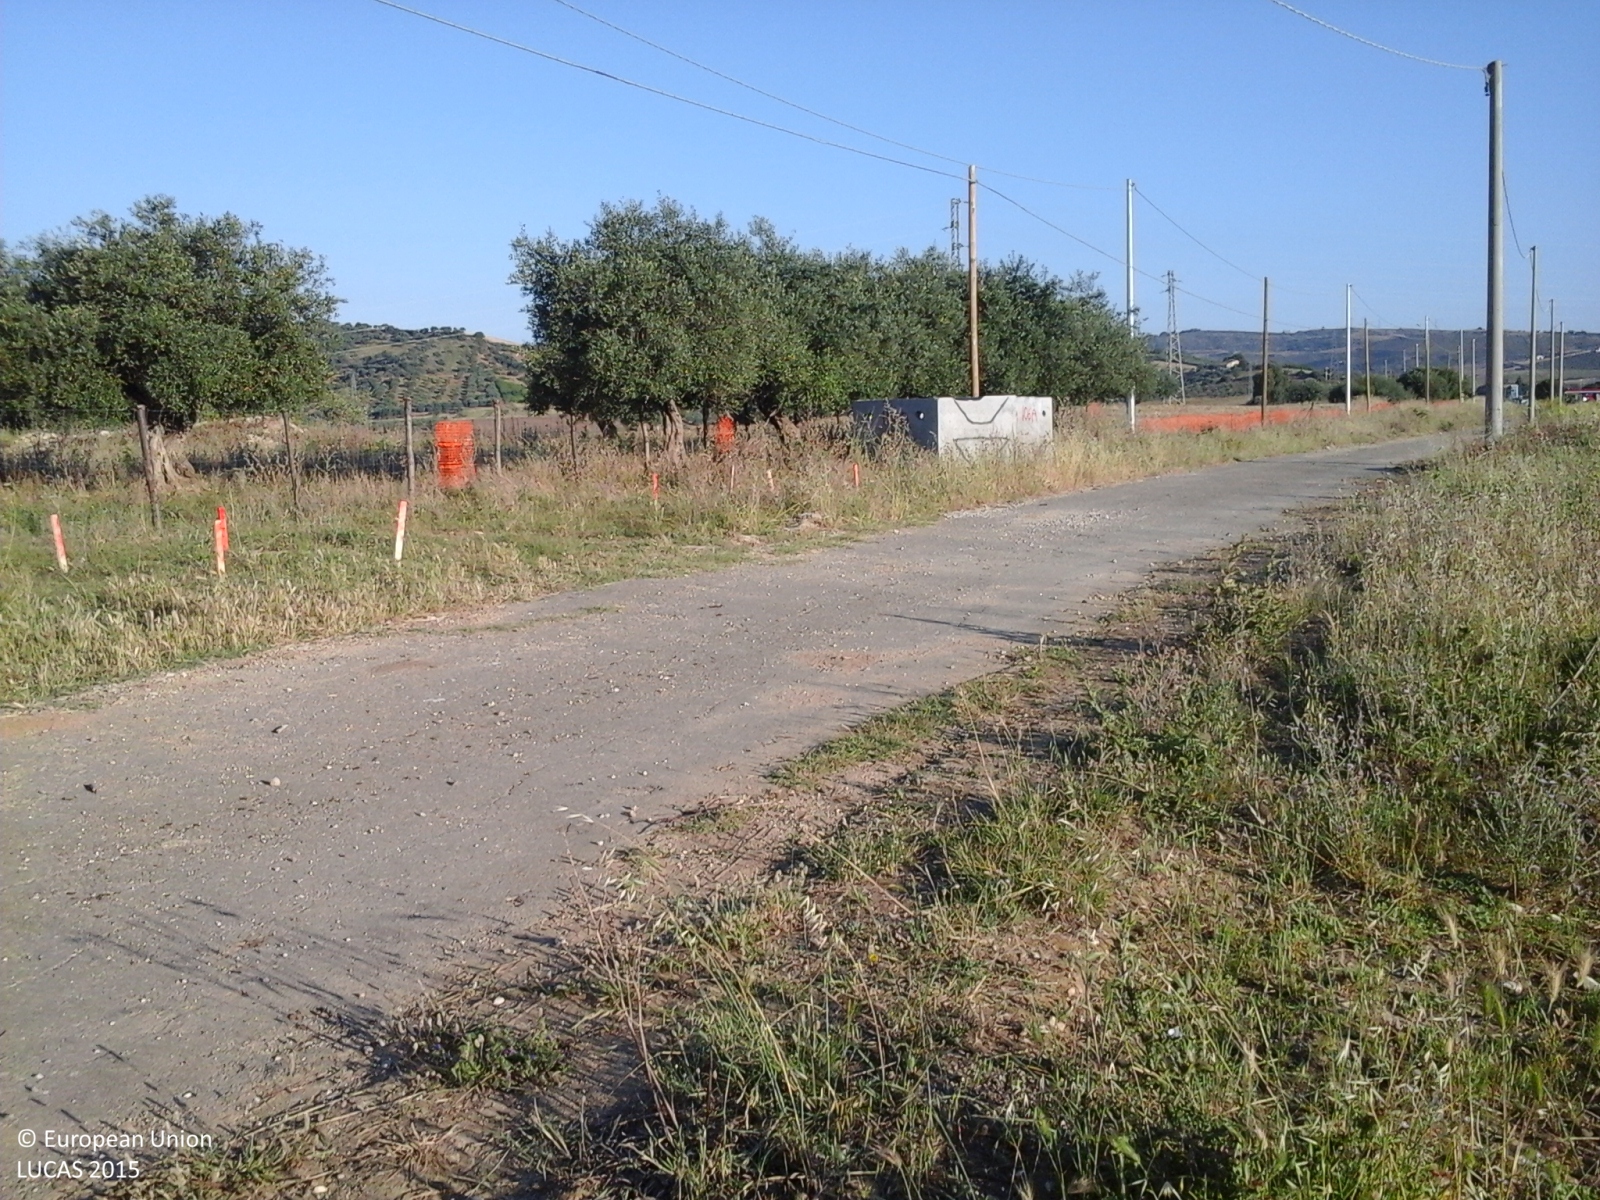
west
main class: Grassland
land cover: Spontaneously vegetated surfaces
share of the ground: > 75 %
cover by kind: herbaceous plants 100 %
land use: Fallow land
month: June
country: IT
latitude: 37.8644
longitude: 13.5098
